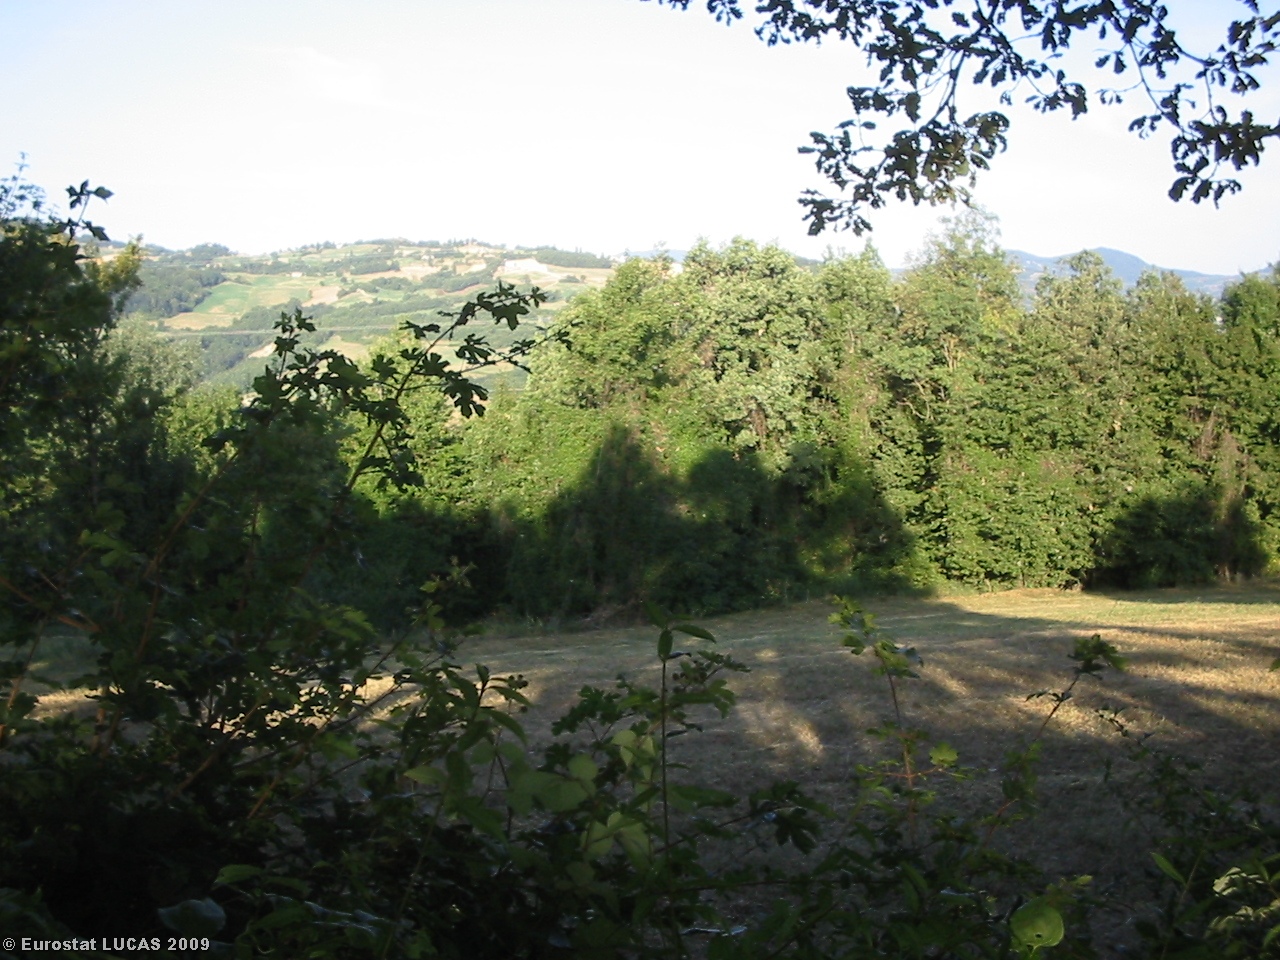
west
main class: Artificial land
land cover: Non built-up linear features
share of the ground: > 75 %
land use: Road transport
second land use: Agriculture (excluding fallow land and kitchen gardens)
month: July
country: IT
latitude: 44.5845
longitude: 10.3142
